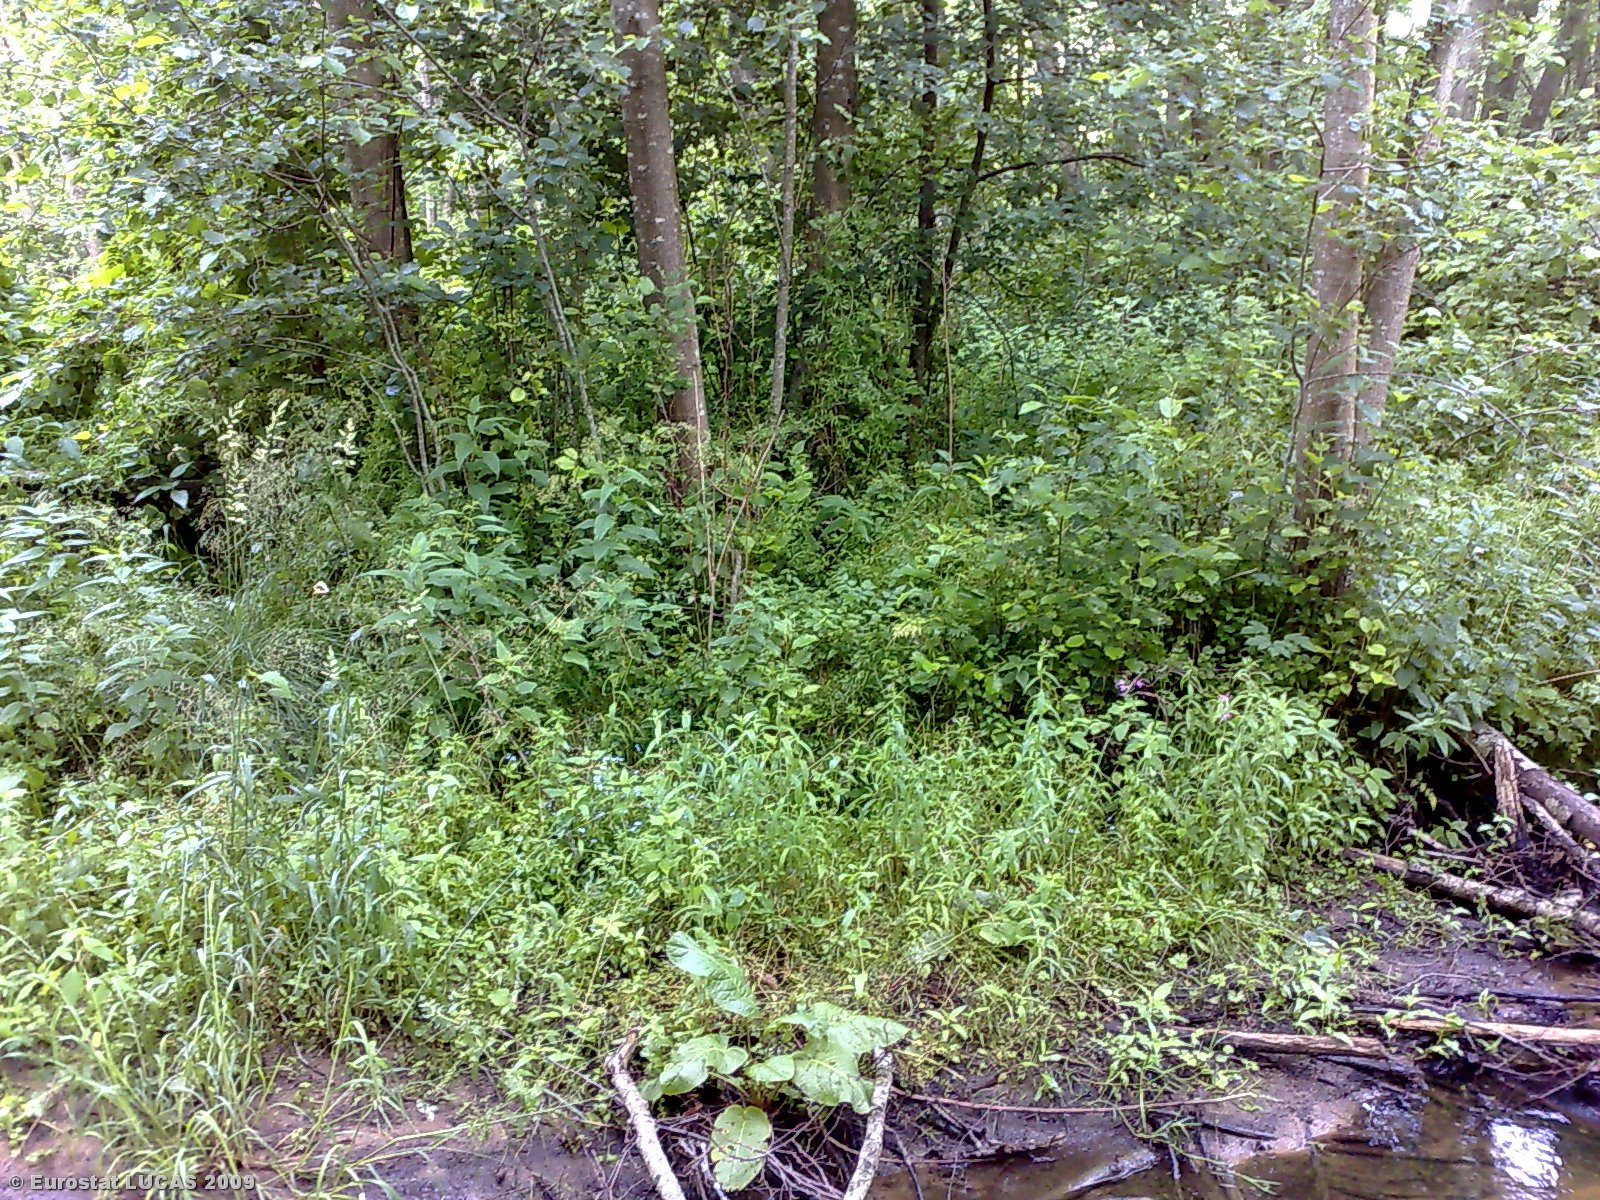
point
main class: Woodland
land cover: Broadleaved woodland
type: floodplain forest
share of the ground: > 75 %
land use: Forestry
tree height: > 5 m
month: July
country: LT
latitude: 55.6916
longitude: 22.7756
